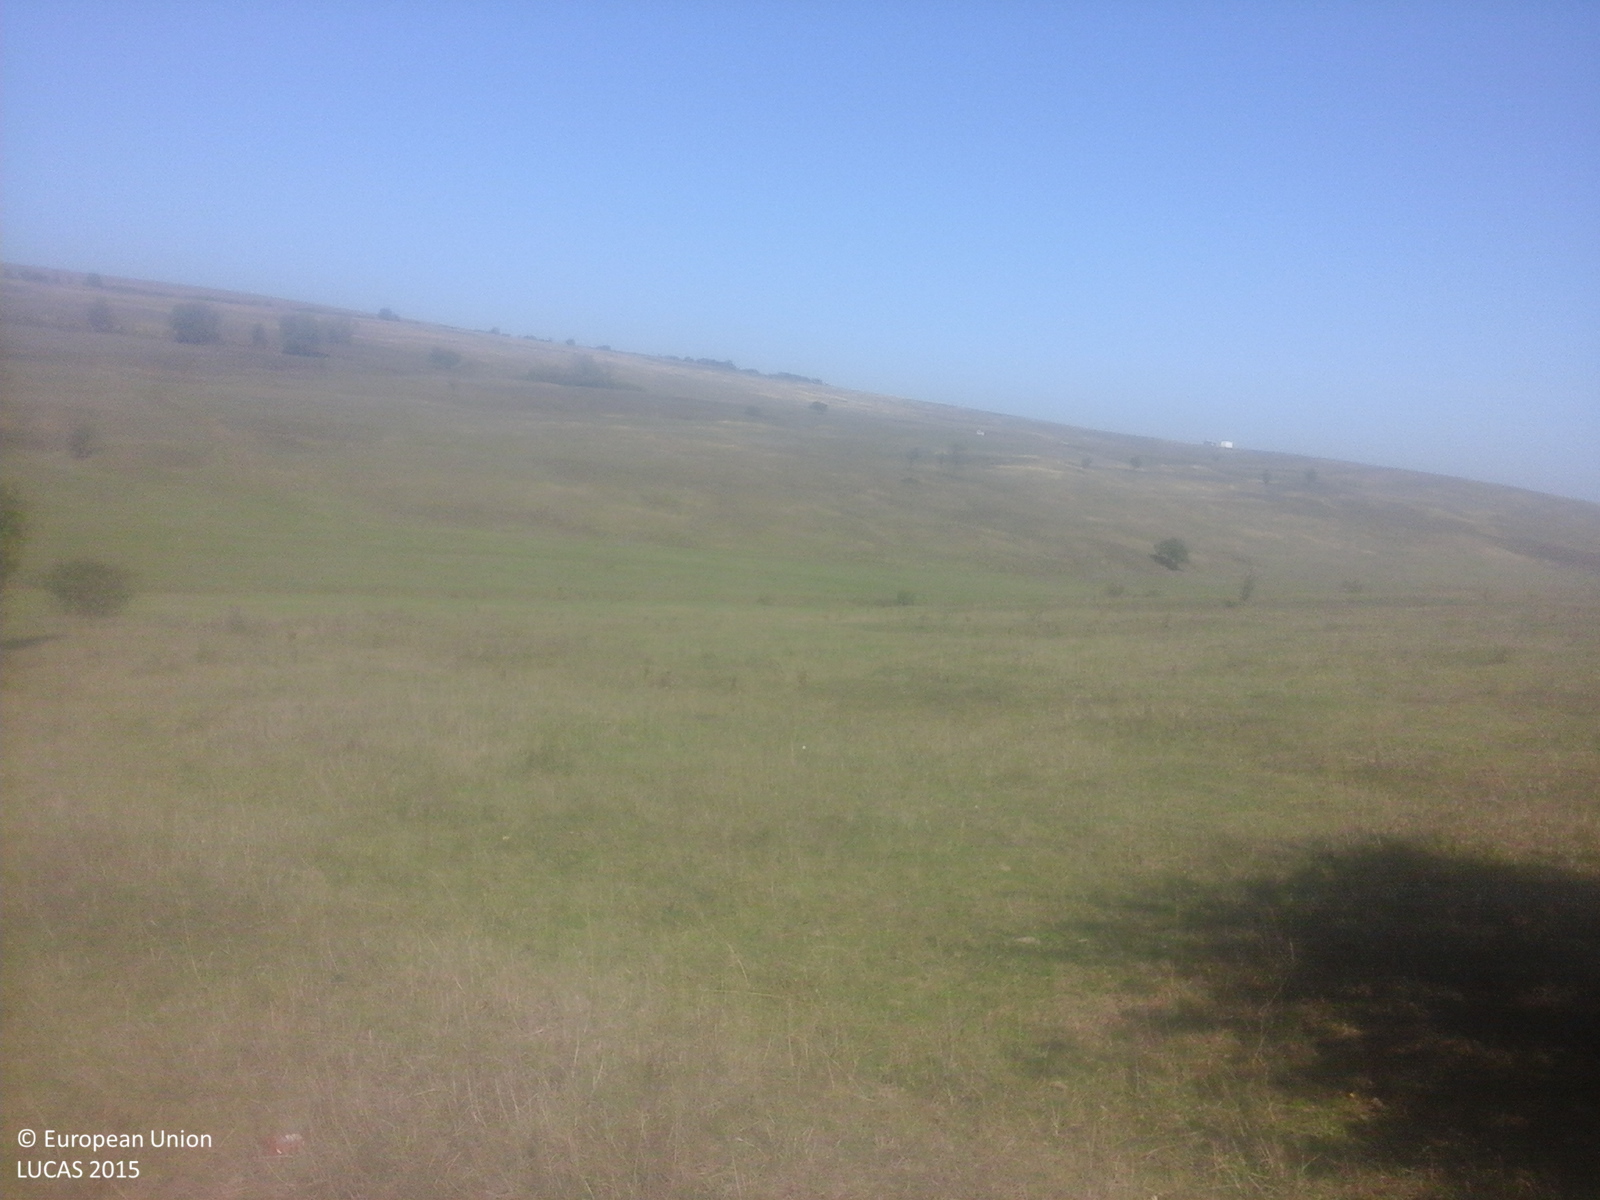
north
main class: Grassland
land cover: Grassland with sparse tree/shrub cover
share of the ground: > 75 %
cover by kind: herbaceous plants 85 %, shrubs 10 %, broadleaved forest trees 5 %
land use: Agriculture (excluding fallow land and kitchen gardens)
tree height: > 5 m
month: October
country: RO
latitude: 46.0110
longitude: 23.8511
